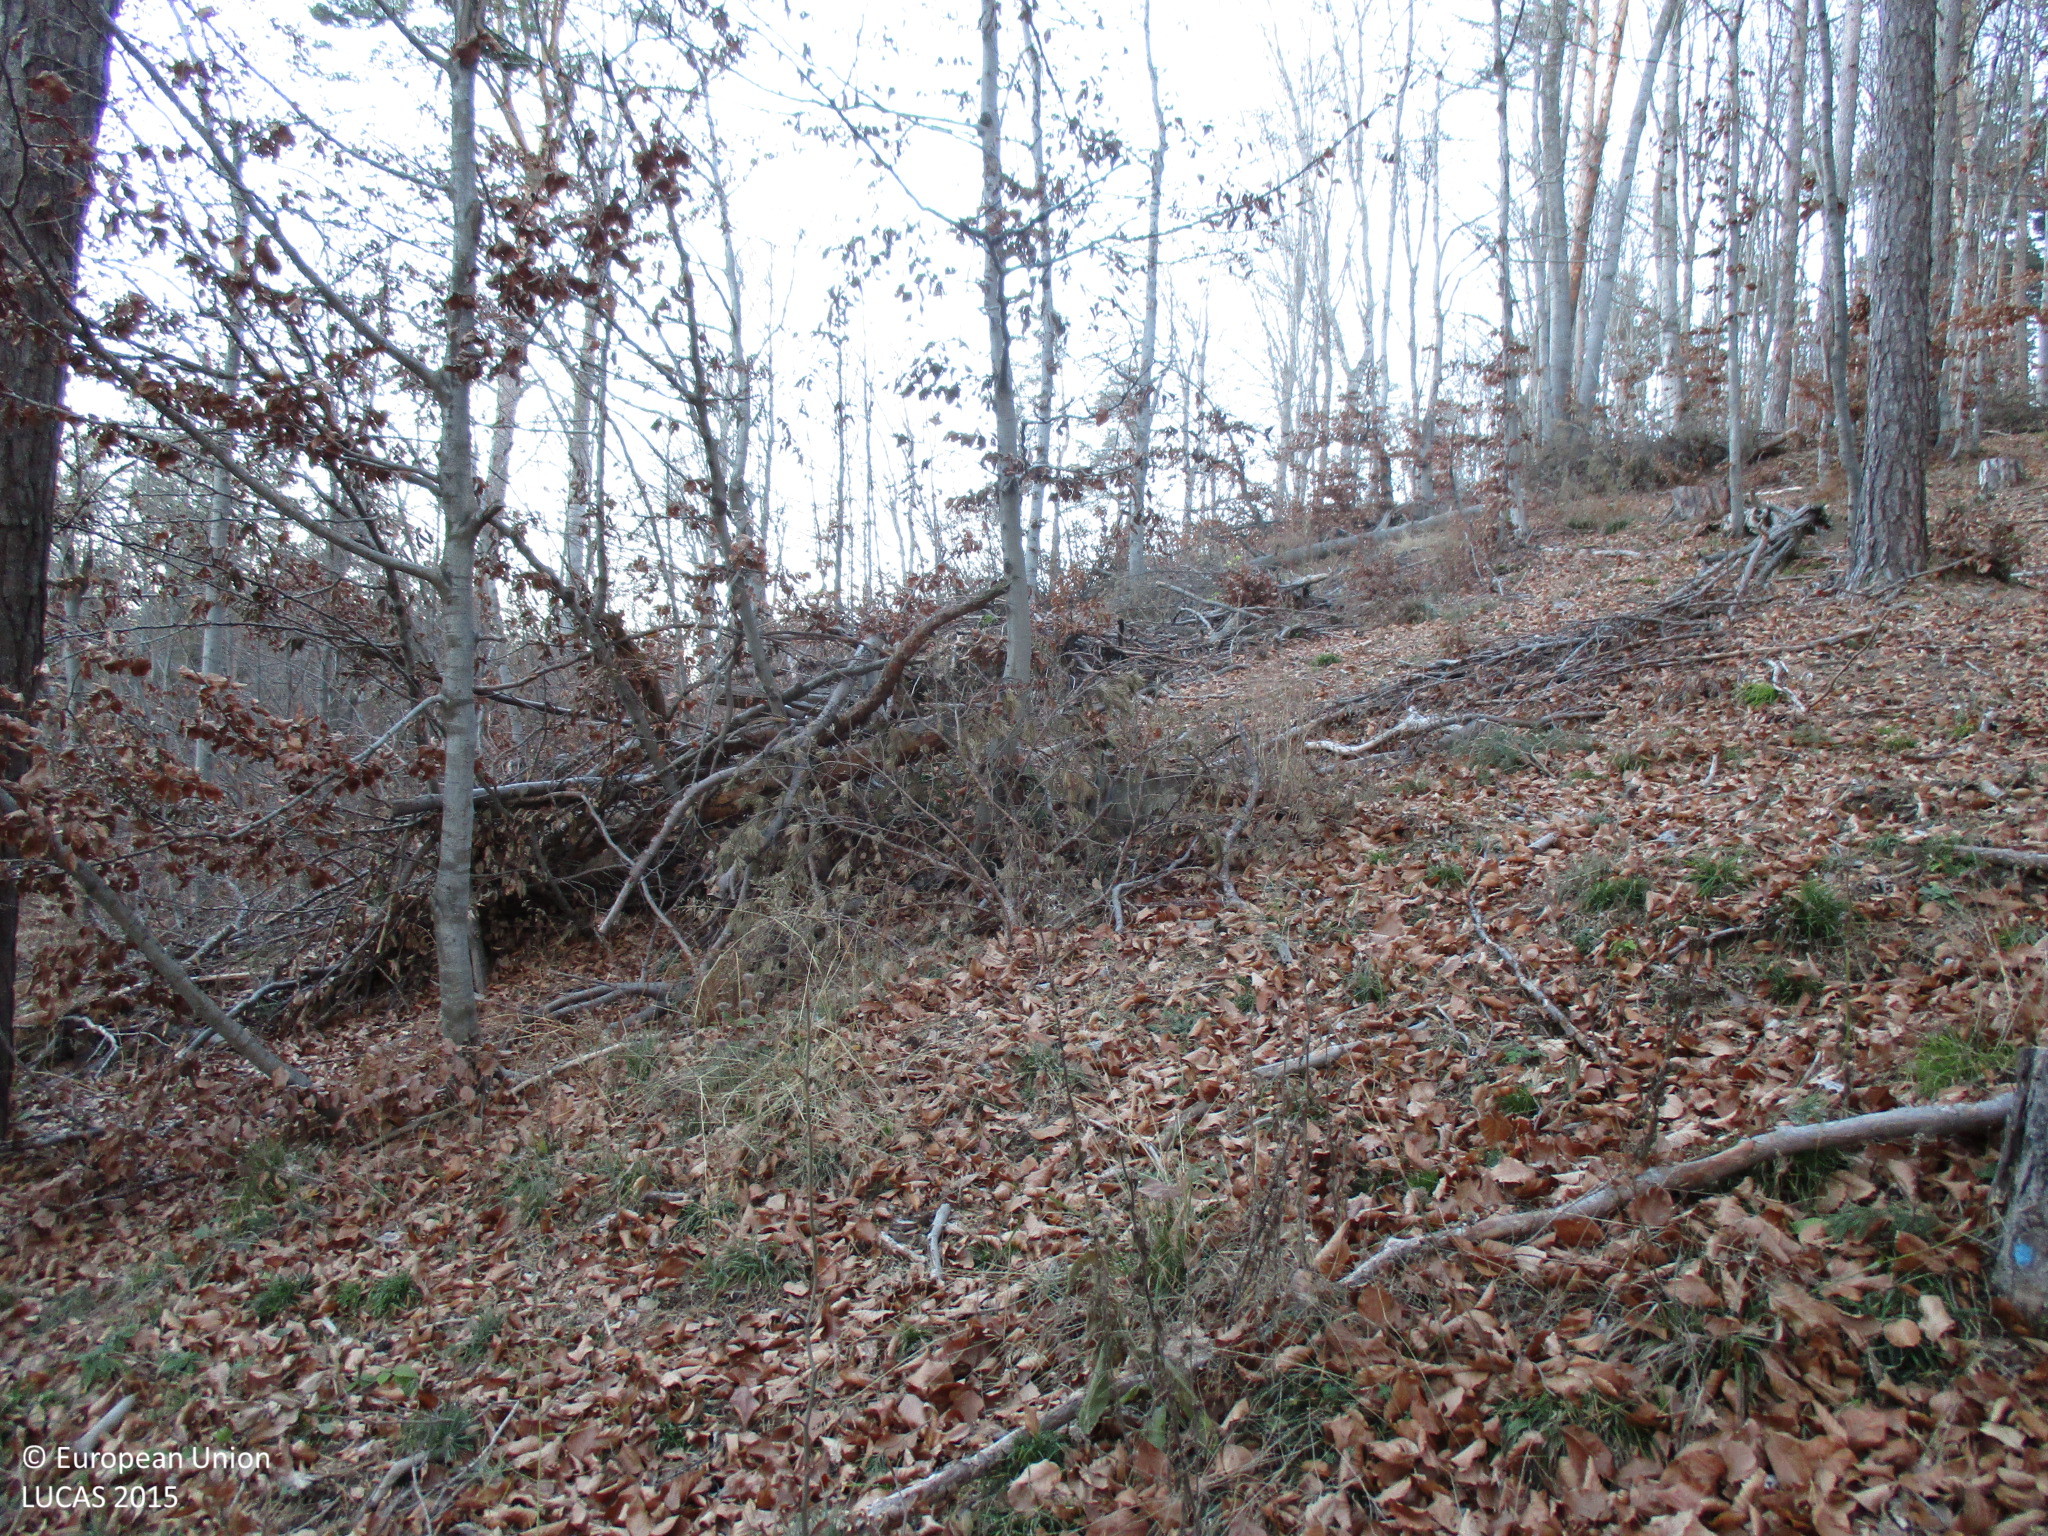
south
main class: Woodland
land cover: Pine dominated mixed woodland
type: hemiboreal forest and nemoral coniferous forest and mixed broadleaved-coniferous forest
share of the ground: > 75 %
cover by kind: coniferous forest trees 65 %, broadleaved forest trees 25 %, shrubs 5 %, herbaceous plants 5 %
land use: Forestry
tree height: > 5 m
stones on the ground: < 10 %
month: December
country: BG
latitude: 42.0044
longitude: 24.6450
